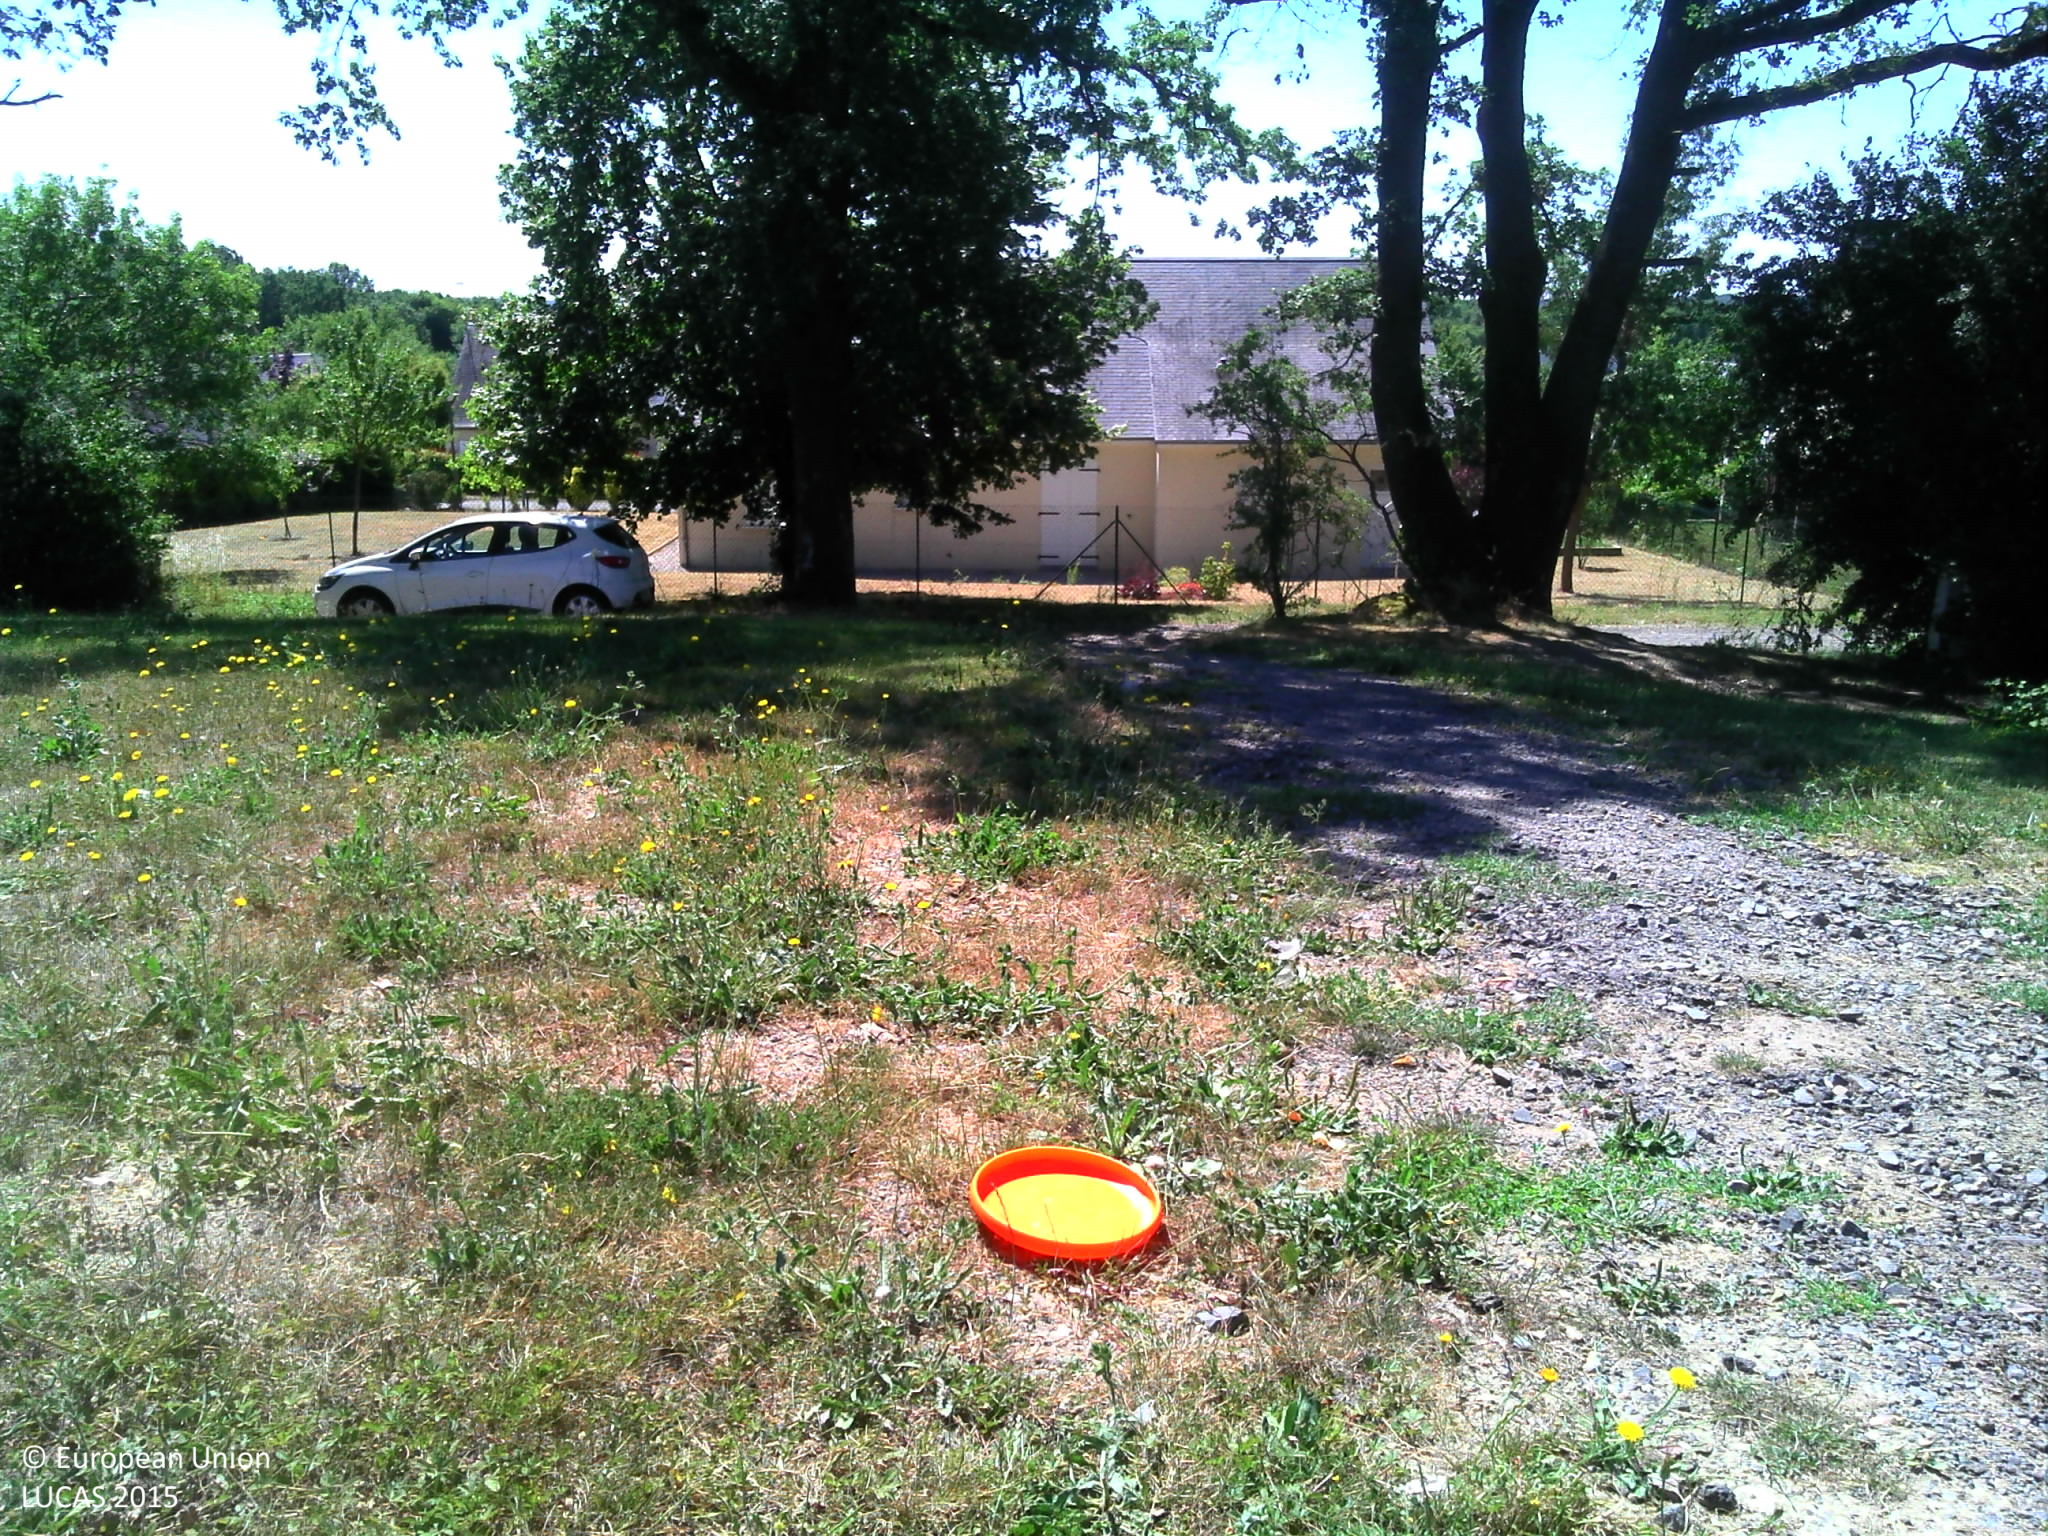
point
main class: Grassland
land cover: Grassland without tree/shrub cover
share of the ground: > 75 %
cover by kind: herbaceous plants 90 %, unconsolidated bare surface 10 %
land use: Community services
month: July
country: FR
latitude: 47.2668
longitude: 0.4763
